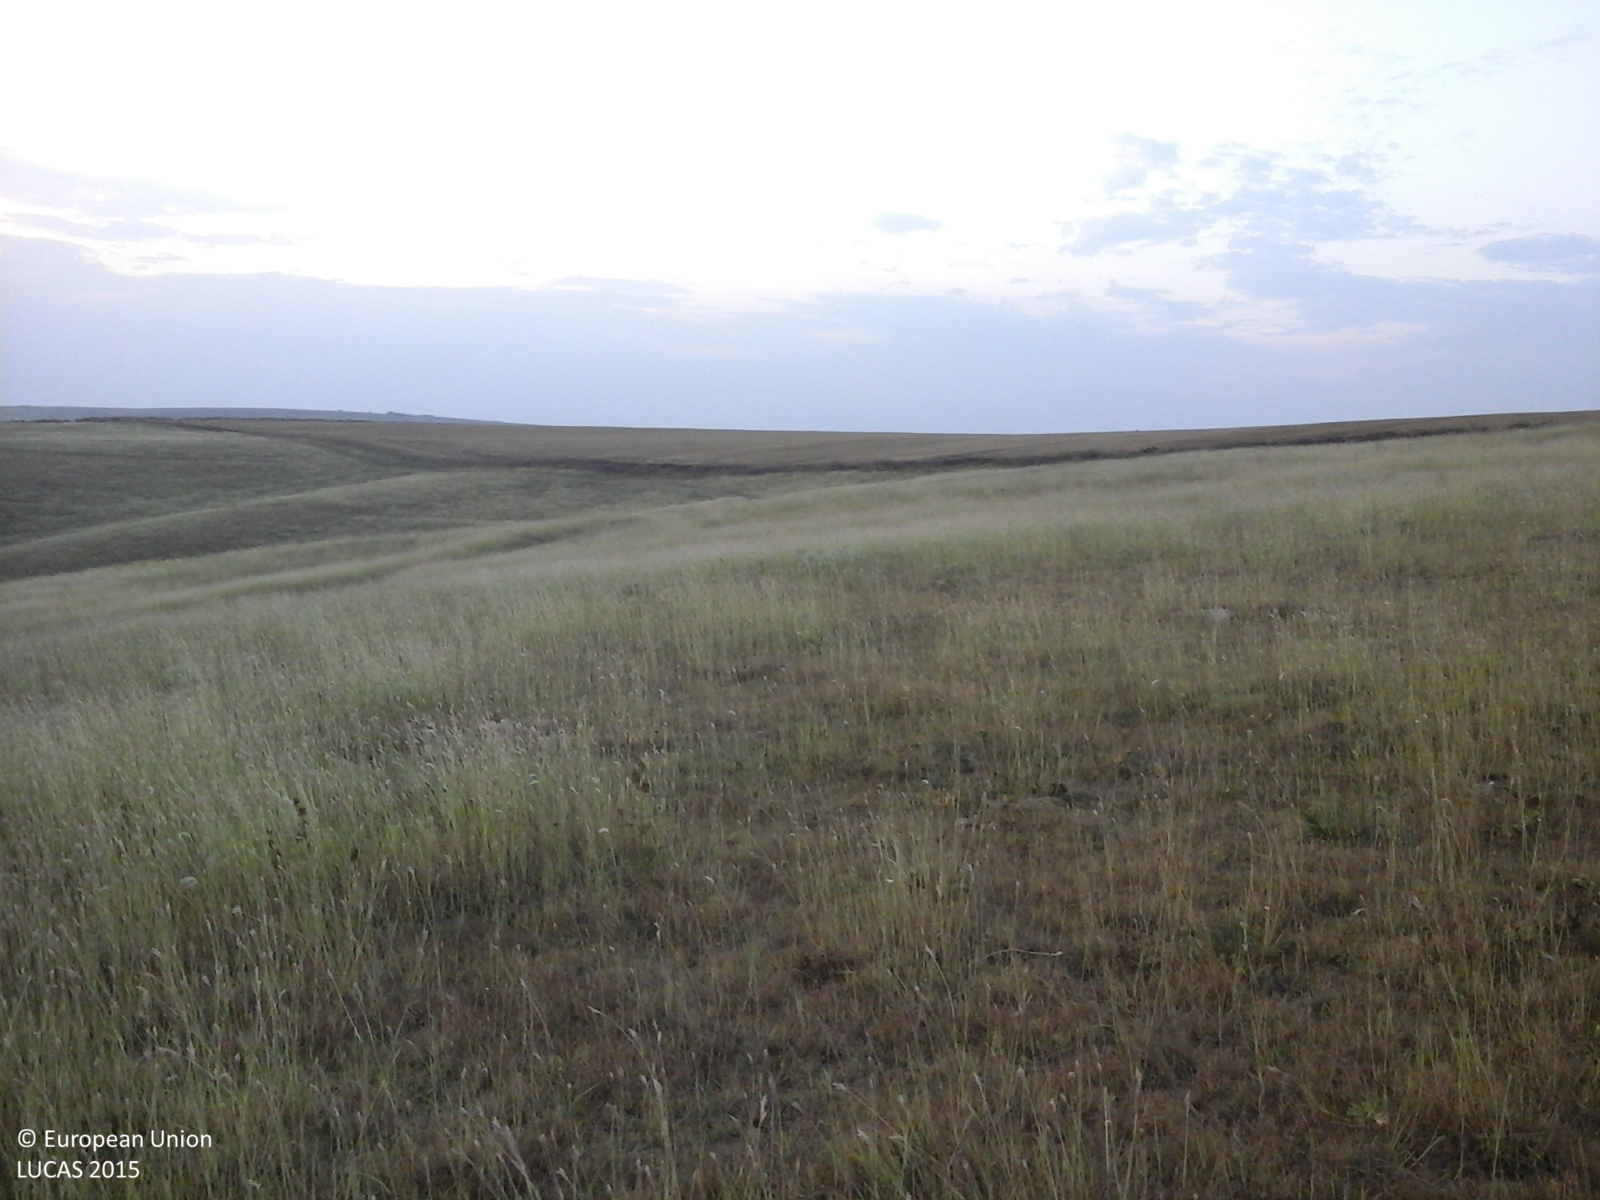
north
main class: Grassland
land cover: Grassland without tree/shrub cover
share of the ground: > 75 %
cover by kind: herbaceous plants 100 %
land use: Agriculture (excluding fallow land and kitchen gardens)
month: August
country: RO
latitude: 44.2194
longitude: 28.0944
